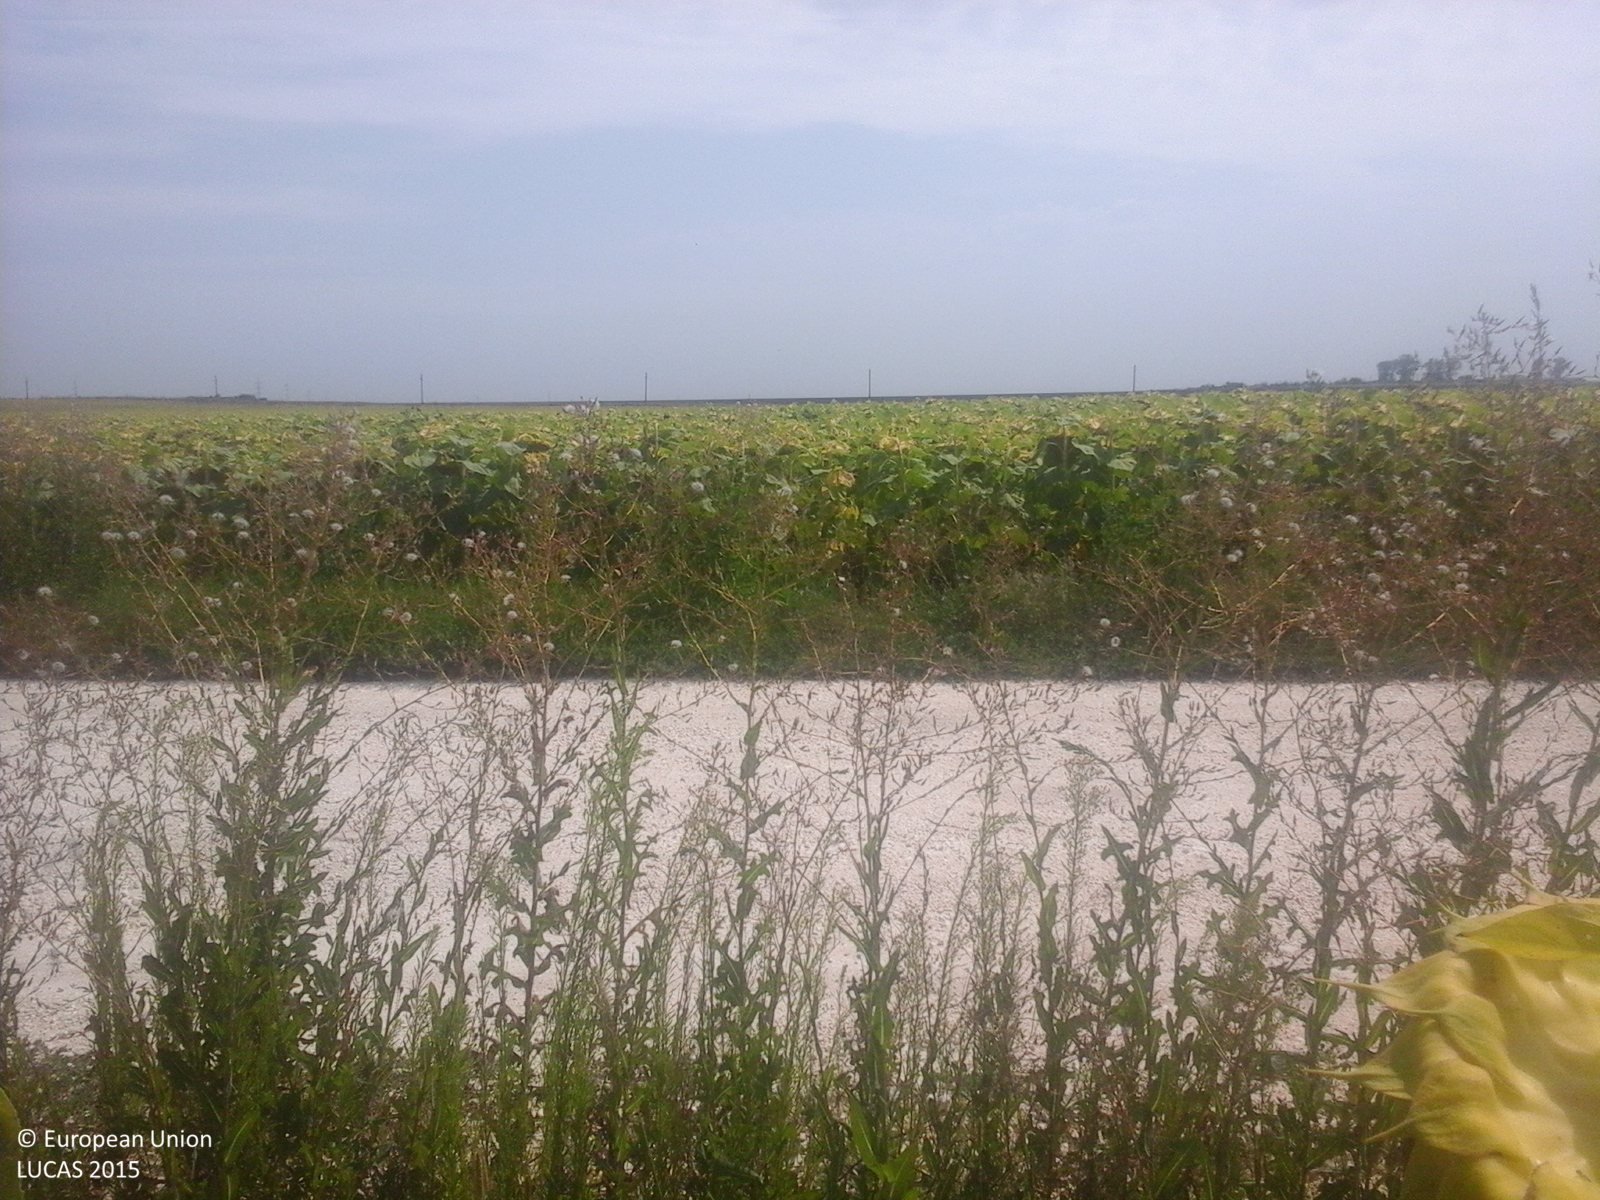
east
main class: Cropland
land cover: Sunflower
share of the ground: > 75 %
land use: Agriculture (excluding fallow land and kitchen gardens)
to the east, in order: Sunflower; Shruby margins; Tracks; Shruby margins; Sunflower
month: August
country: RO
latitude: 43.8882
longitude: 28.1929
